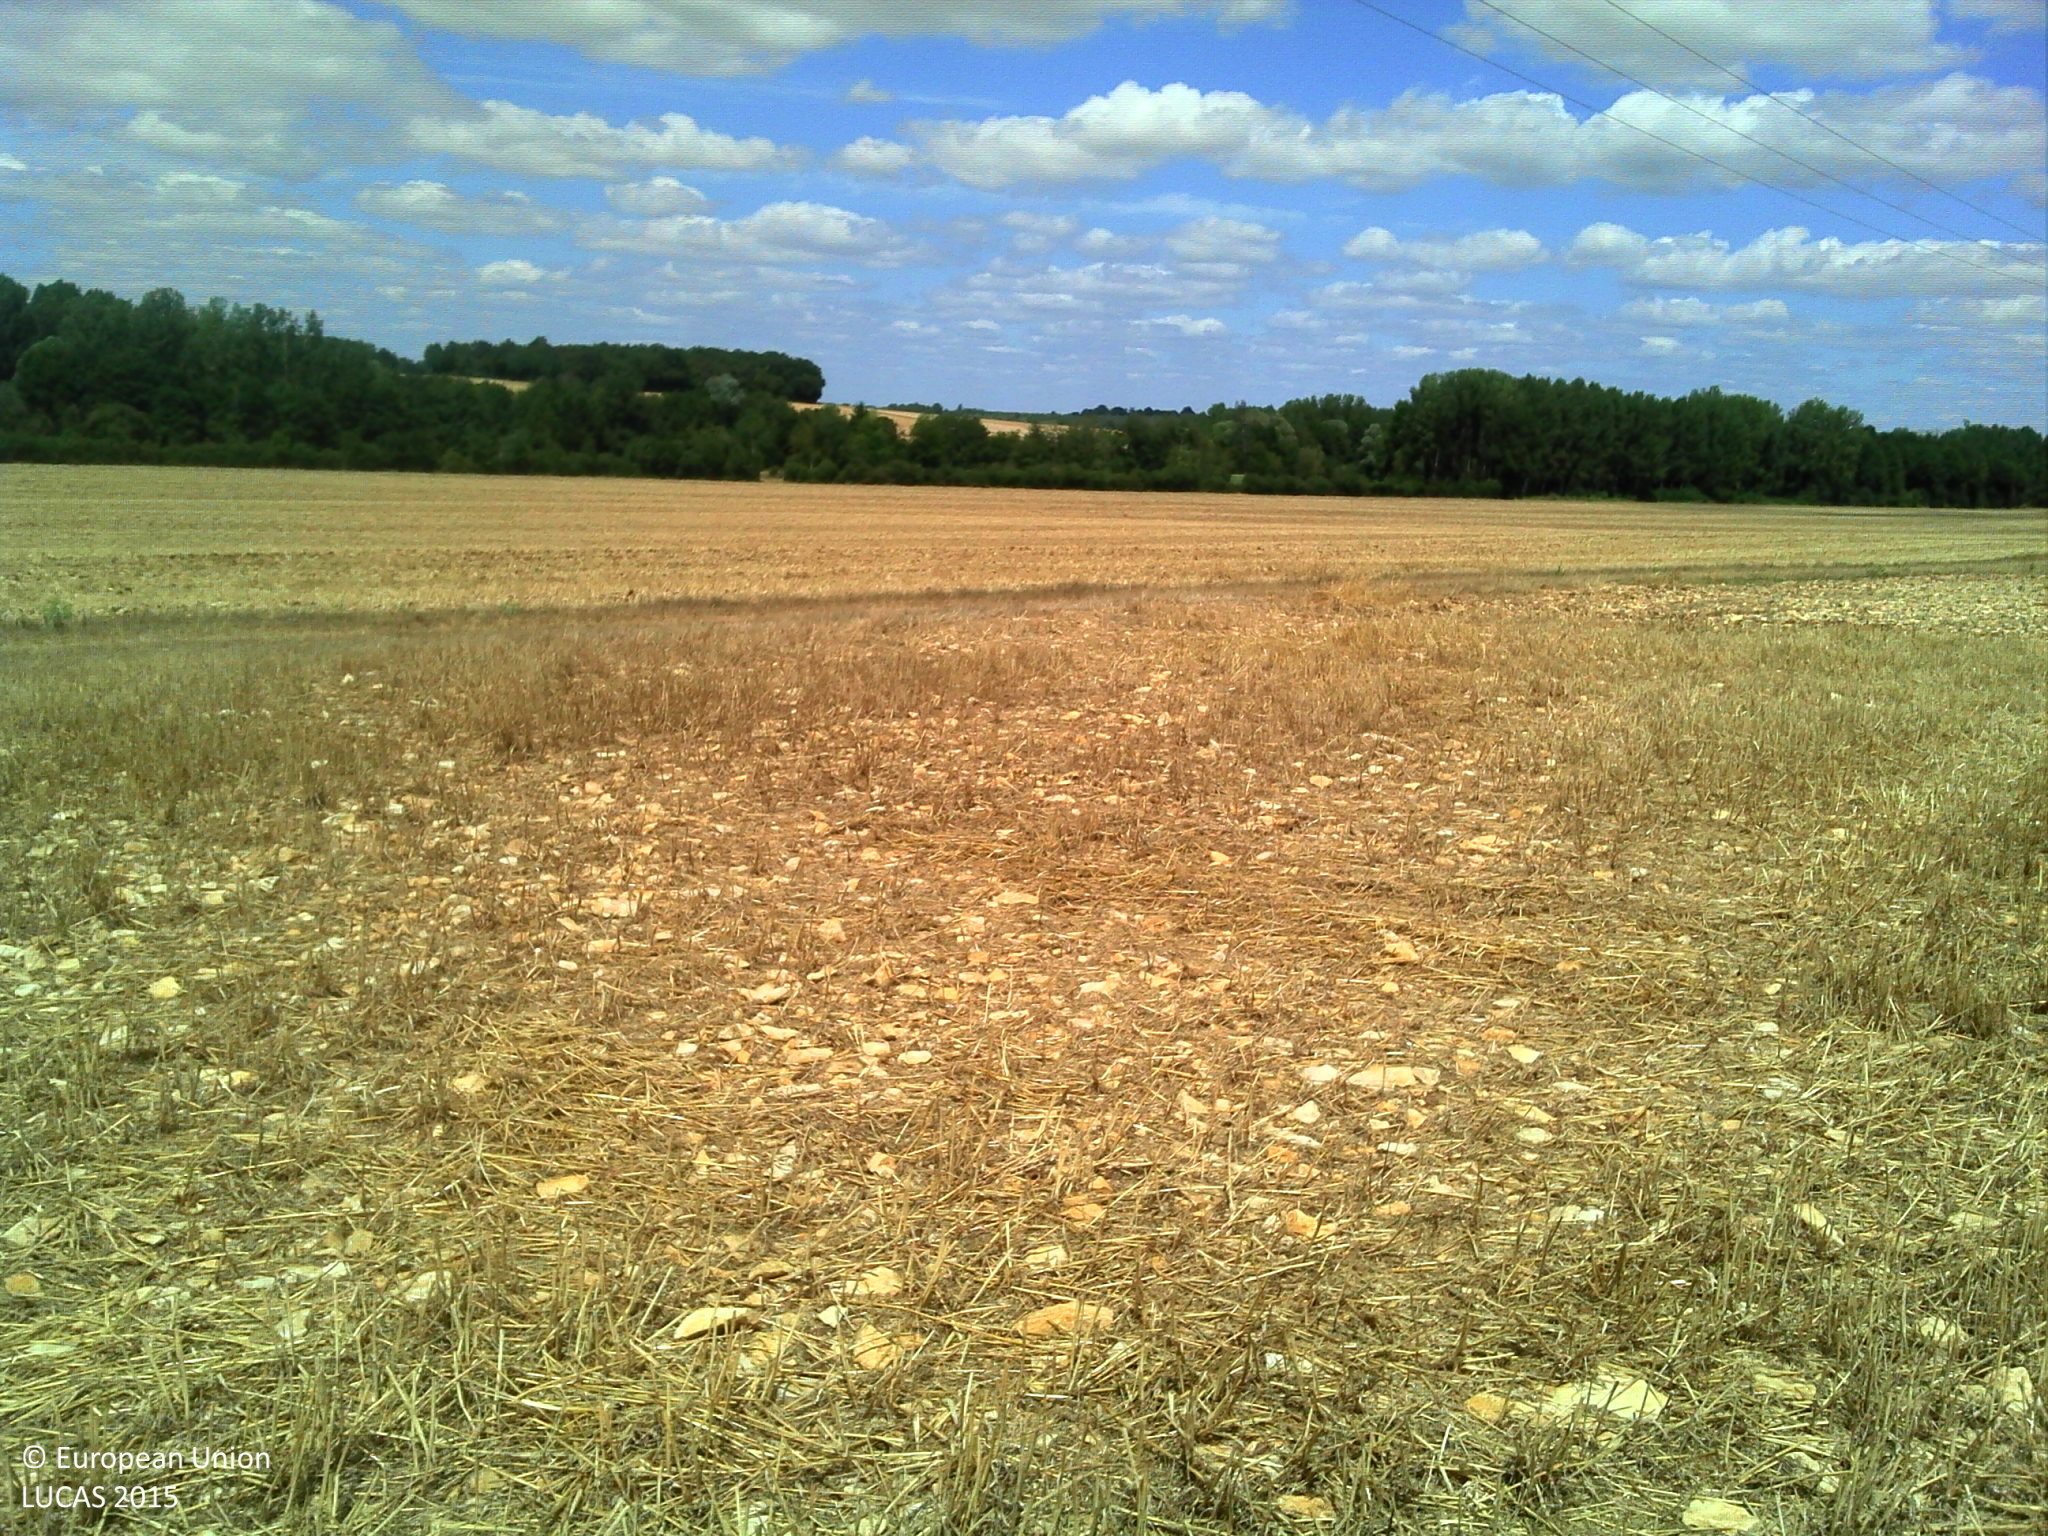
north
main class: Cropland
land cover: Common wheat
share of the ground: > 75 %
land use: Agriculture (excluding fallow land and kitchen gardens)
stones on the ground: 10 - 25 %
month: July
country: FR
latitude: 46.9468
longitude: 2.1220
